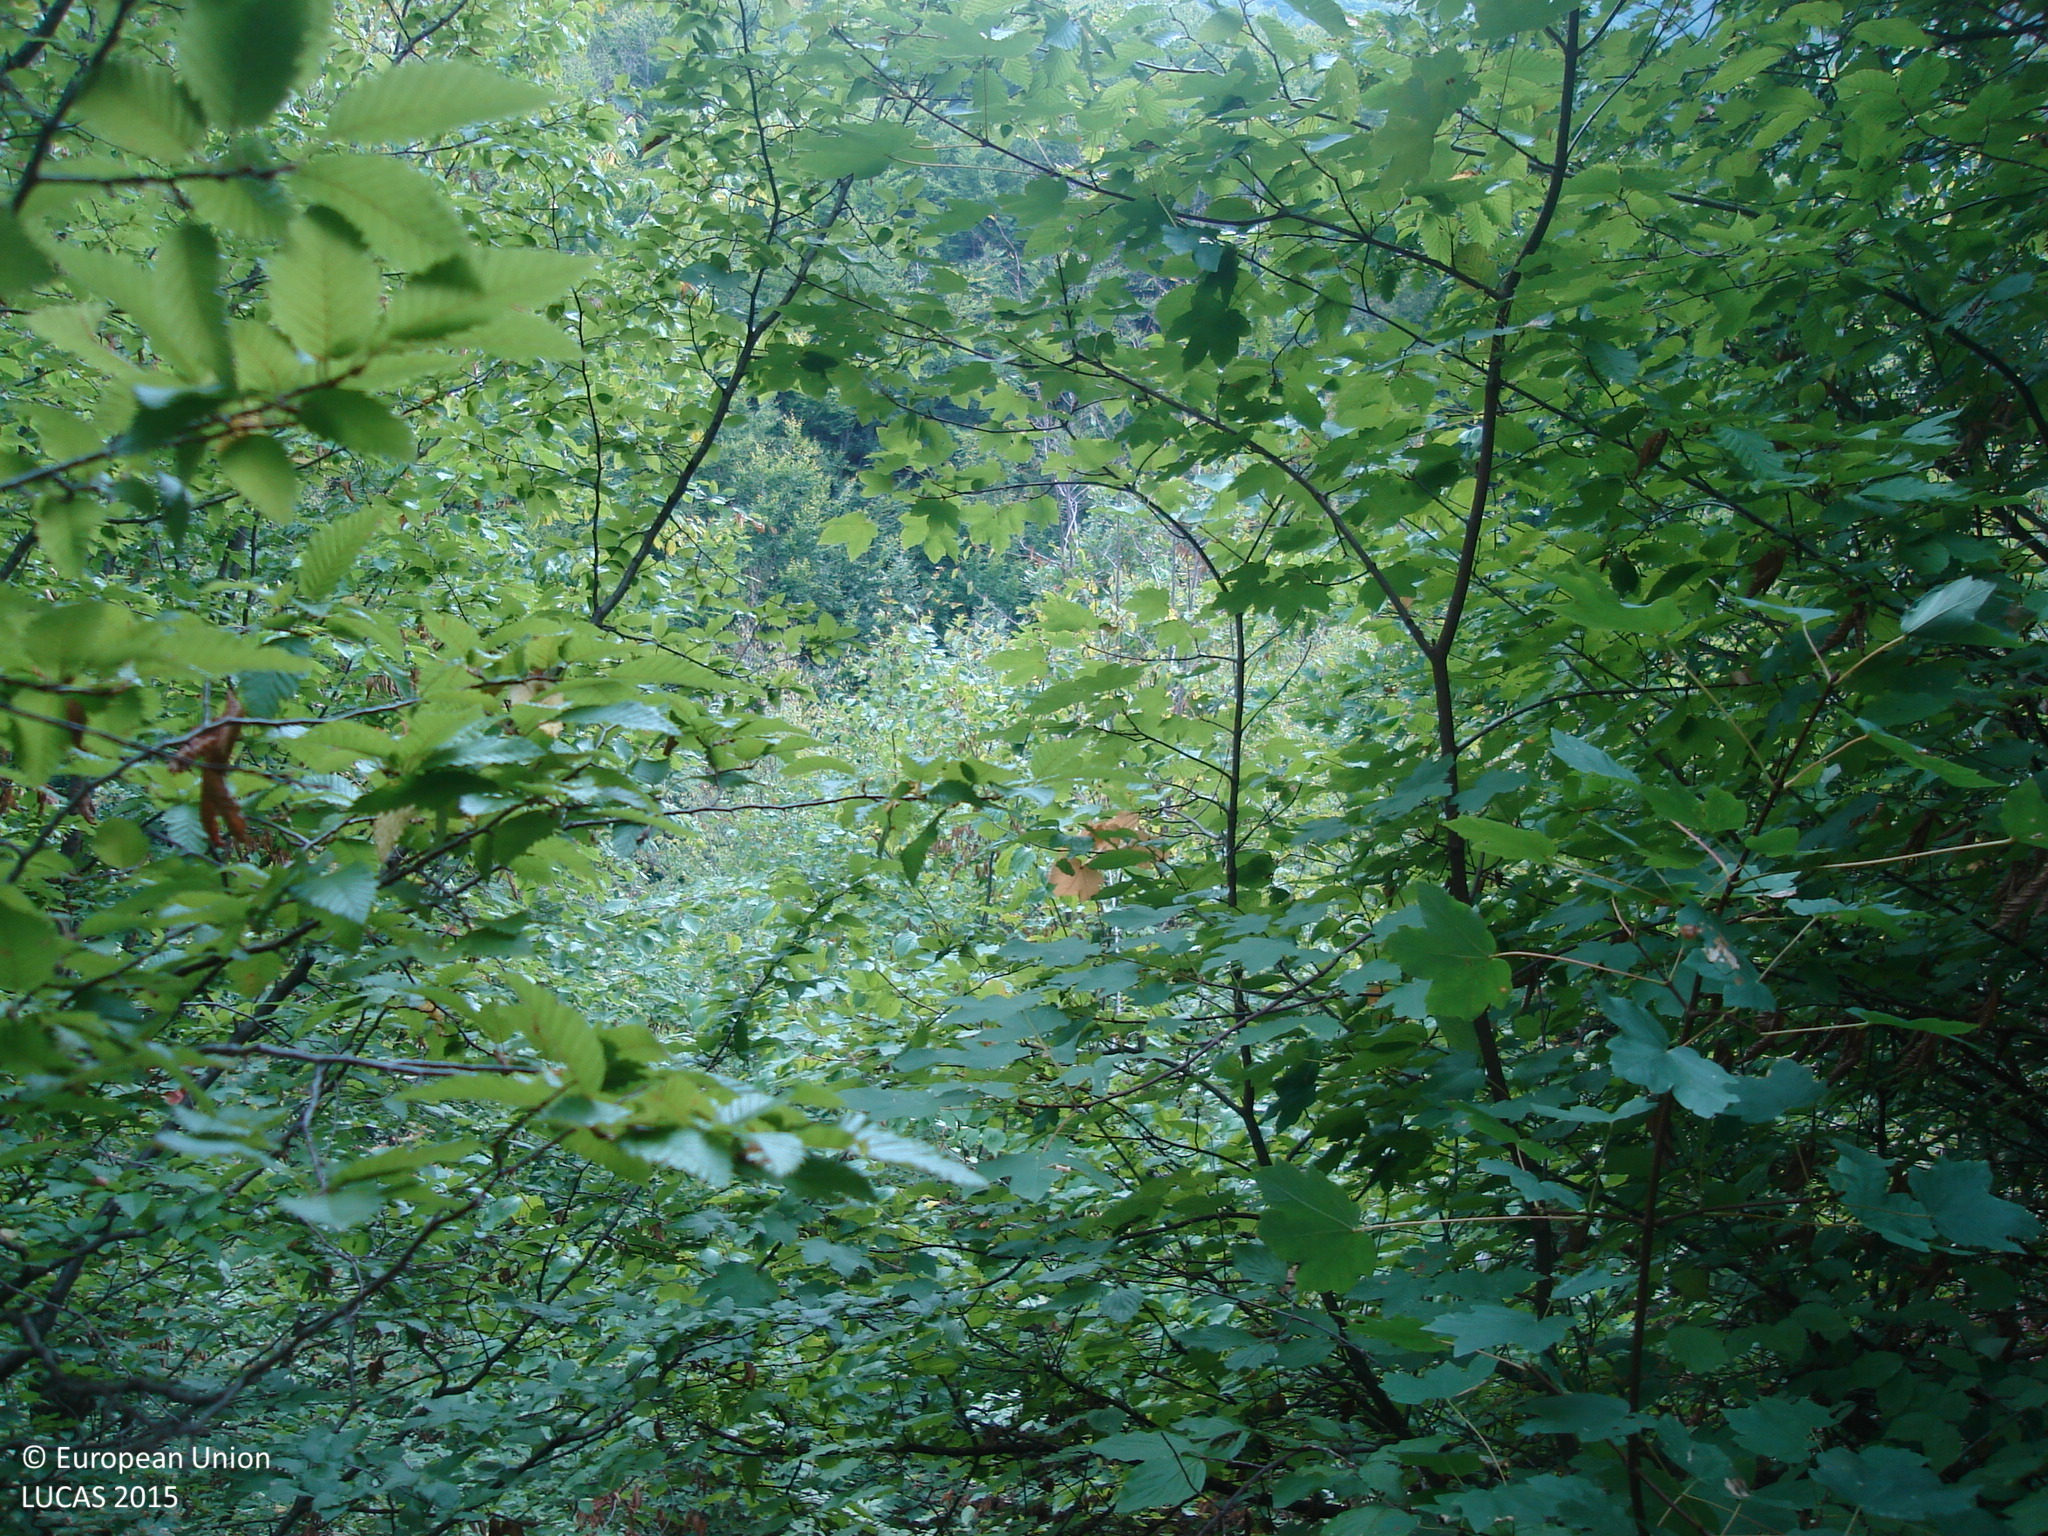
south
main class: Woodland
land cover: Broadleaved woodland
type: thermophilous deciduous forest
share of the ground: > 75 %
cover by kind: broadleaved forest trees 95 %, consolidated bare surface 5 %
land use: Forestry
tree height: > 5 m
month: September
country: BG
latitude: 43.0861
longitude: 23.3168
